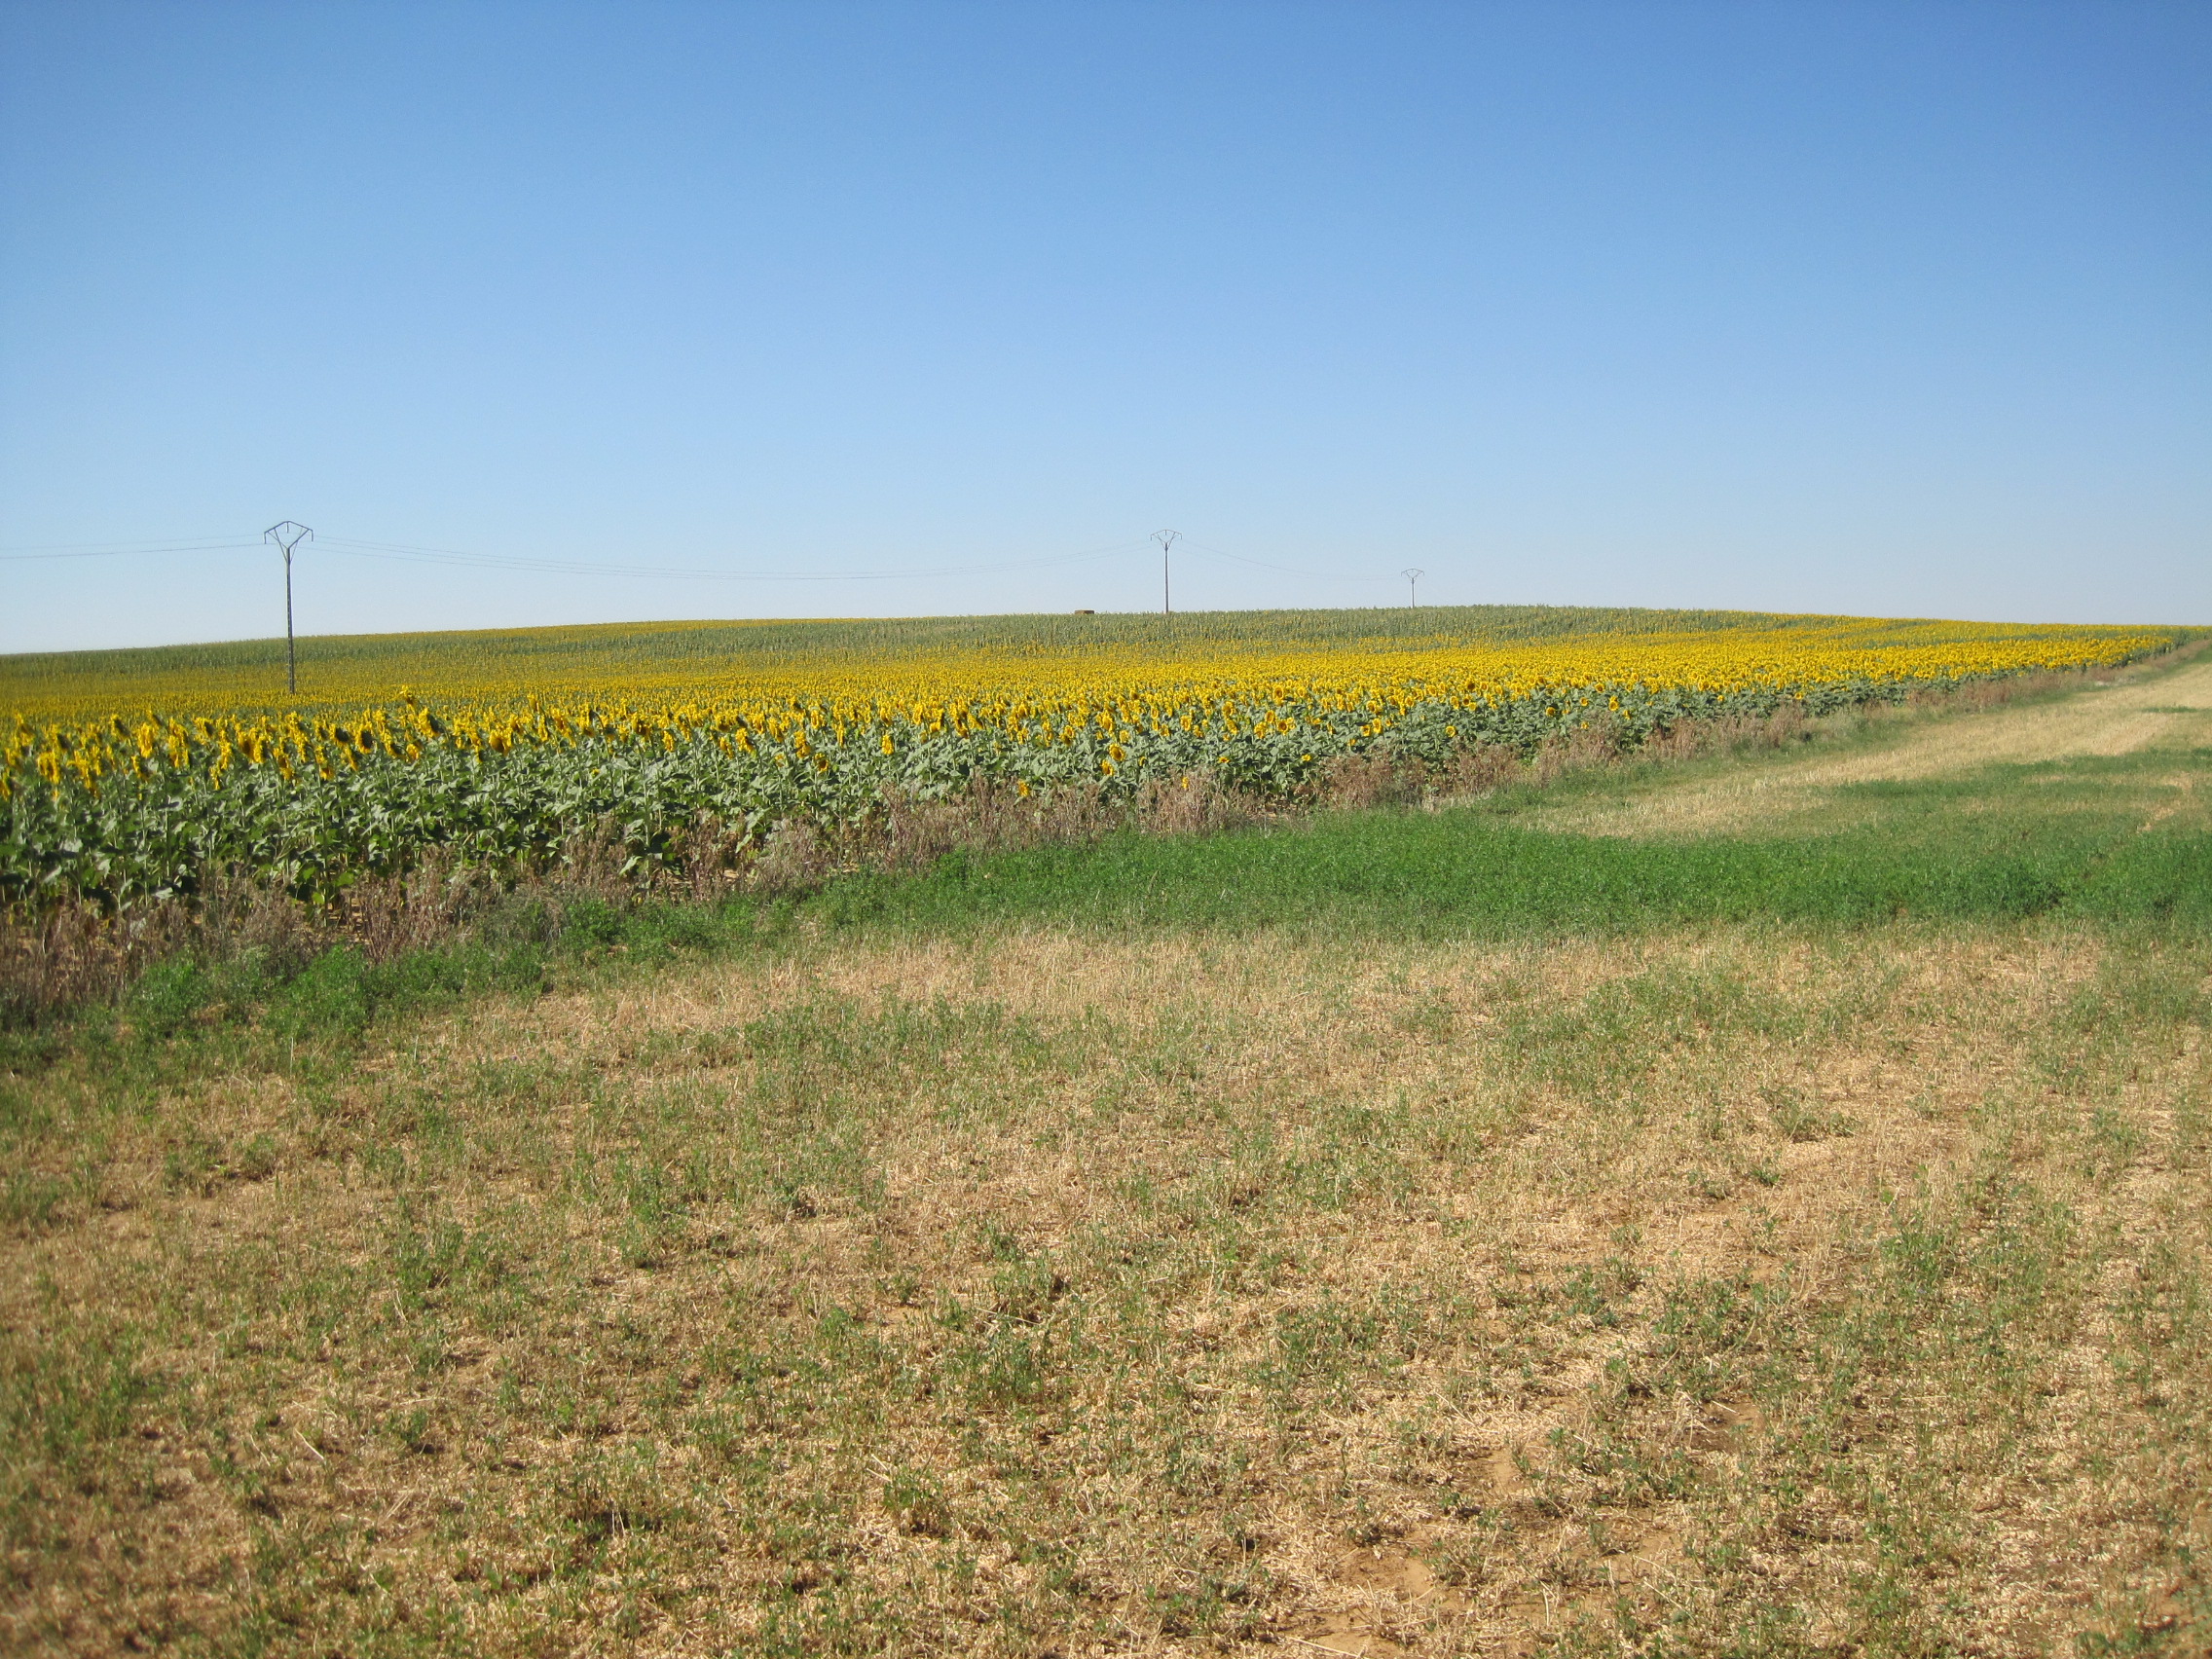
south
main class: Cropland
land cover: Lucerne
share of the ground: 25 - 50 %
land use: Agriculture (excluding fallow land and kitchen gardens)
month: July
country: ES
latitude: 42.0851
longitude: -5.2067
